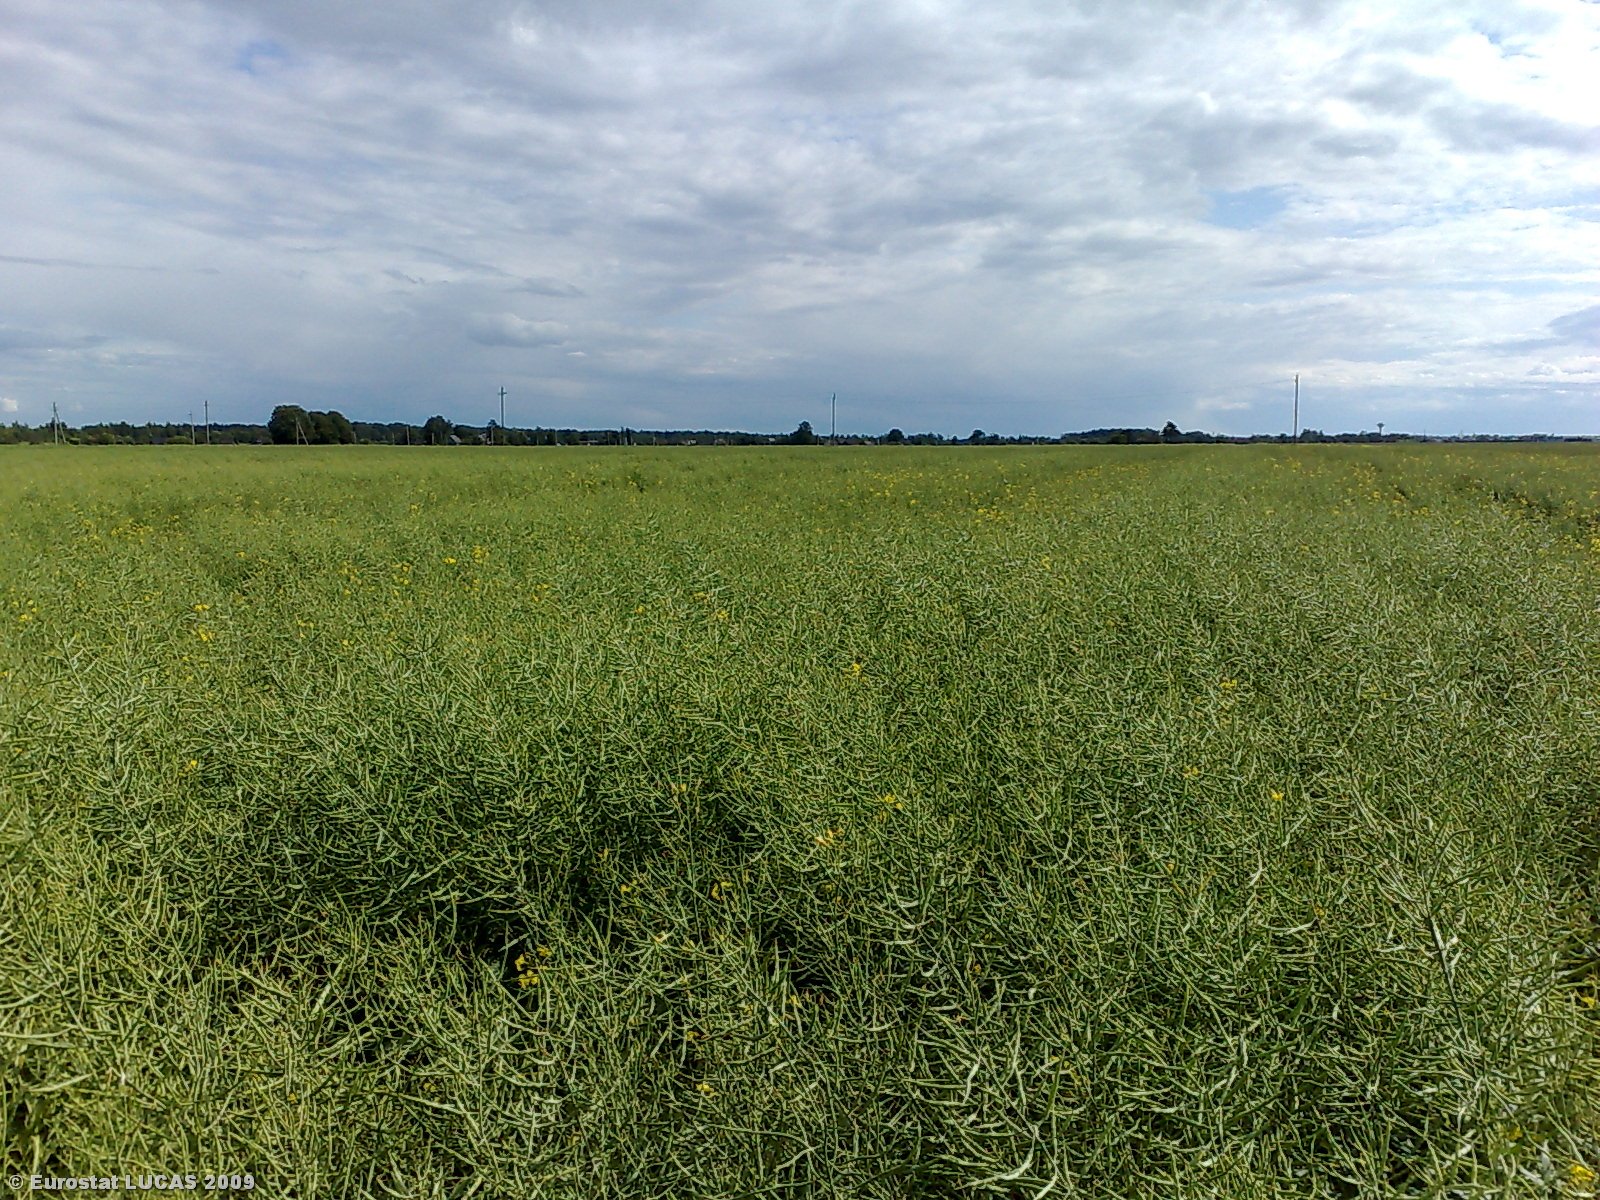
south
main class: Cropland
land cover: Rape and turnip rape
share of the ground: > 75 %
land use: Agriculture (excluding fallow land and kitchen gardens)
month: June
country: LT
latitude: 56.0116
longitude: 23.8951
